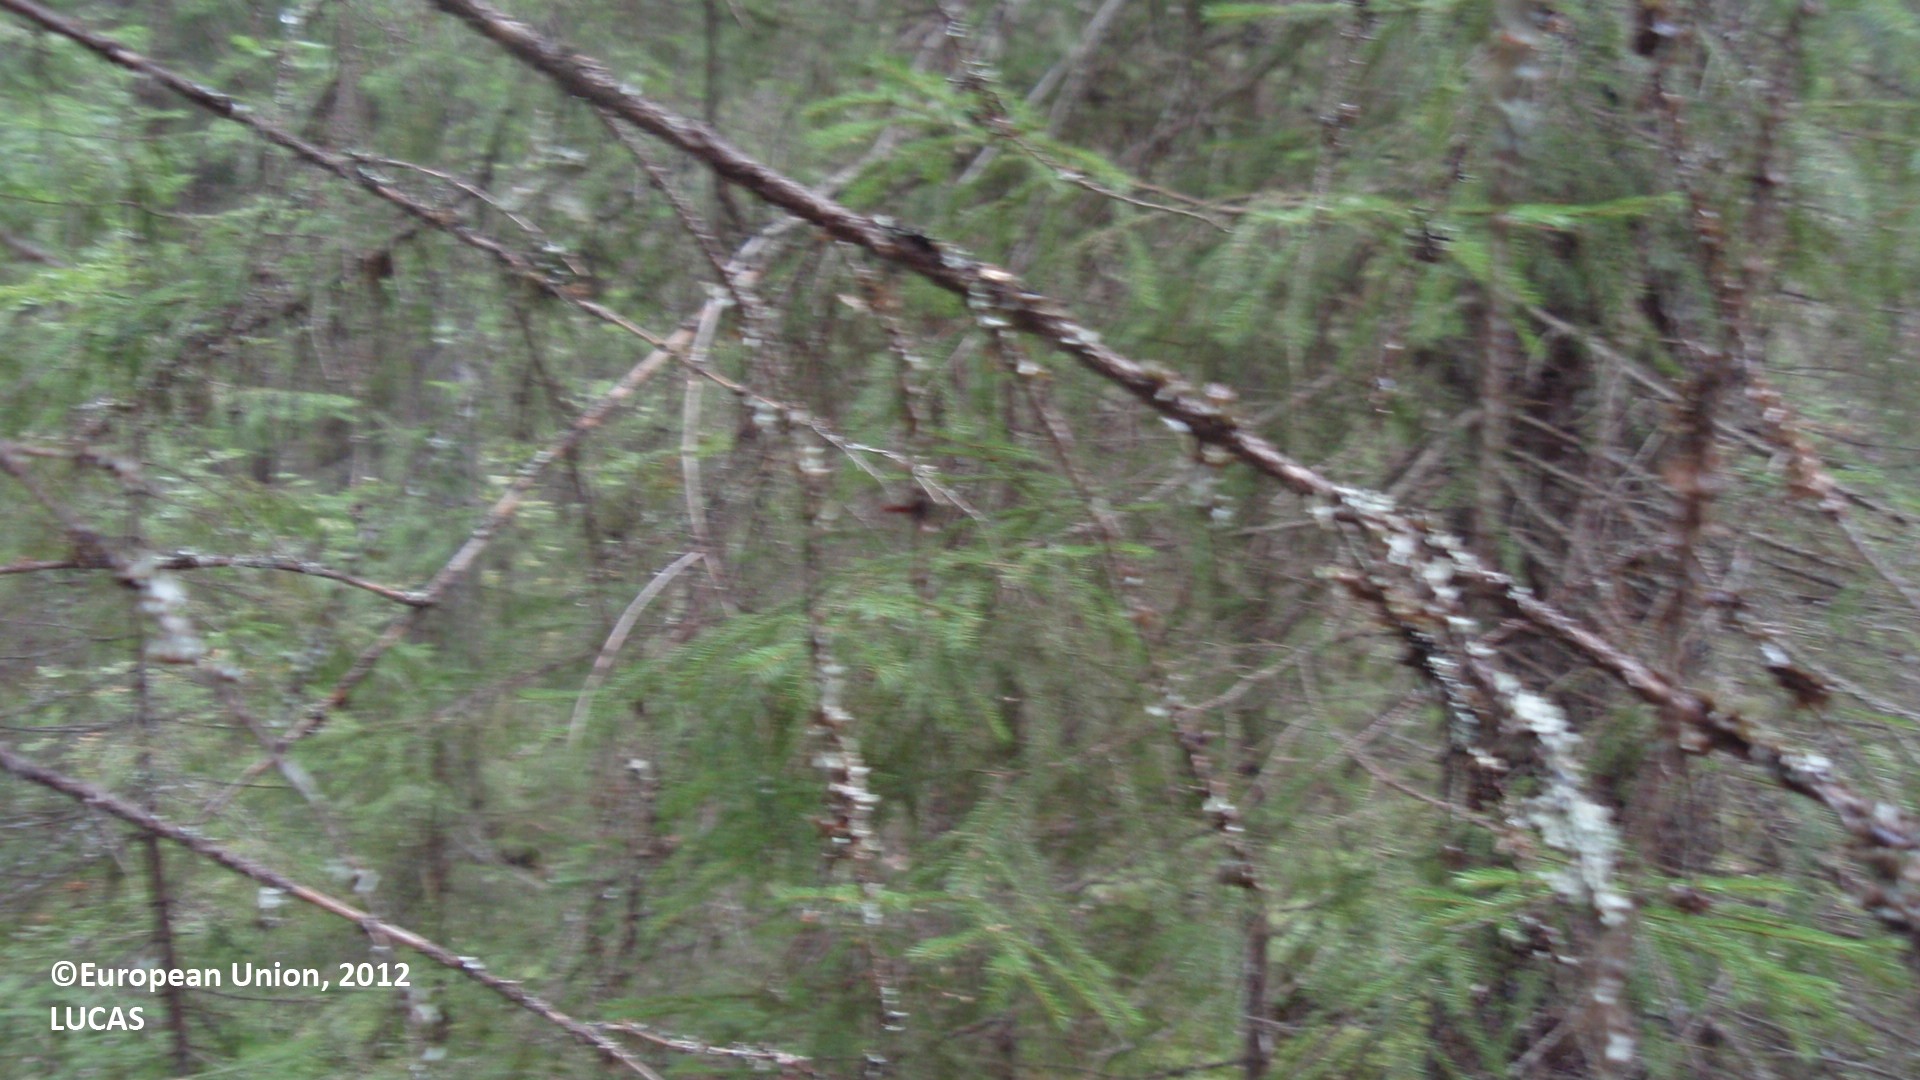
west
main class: Woodland
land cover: Spruce dominated mixed woodland
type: boreal forest
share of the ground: 50 - 75 %
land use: Forestry
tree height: > 5 m
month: August
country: FI
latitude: 60.8375
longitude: 27.4571
